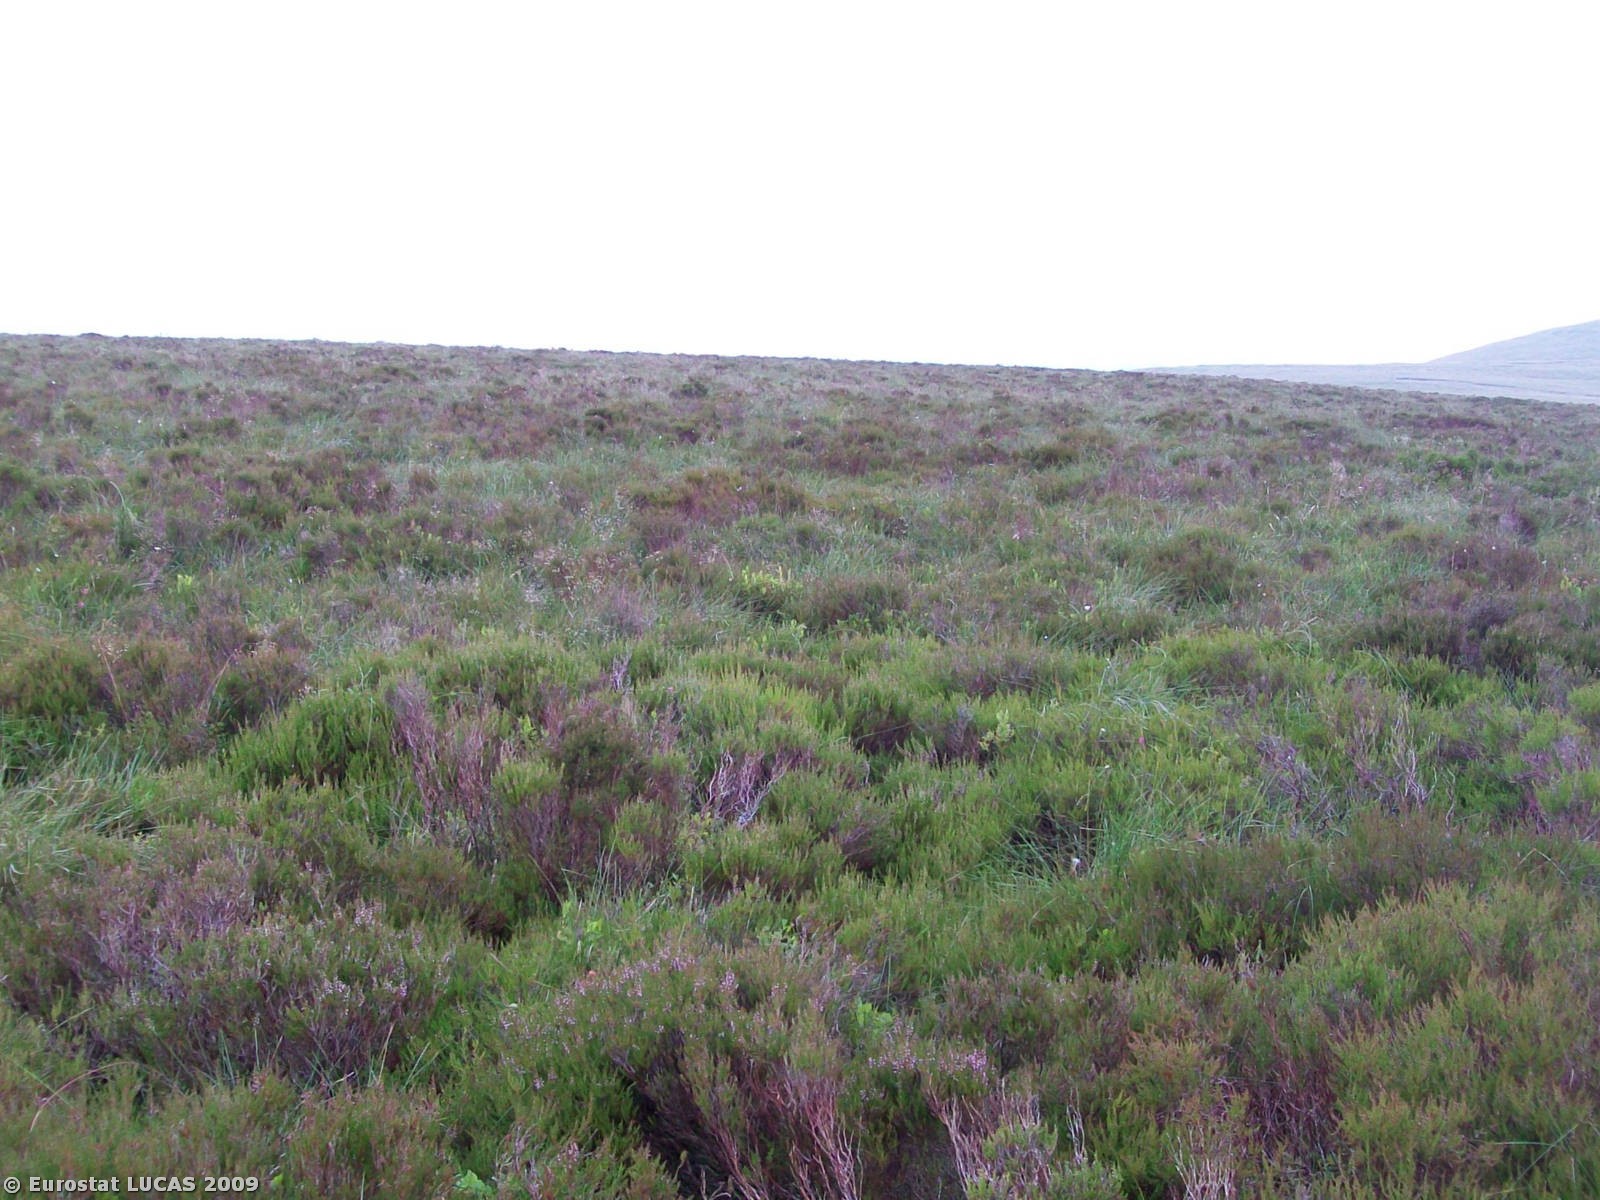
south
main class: Wetlands
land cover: Peatbogs
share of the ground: > 75 %
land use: Unused
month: July
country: GB
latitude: 55.0142
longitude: -6.2382
